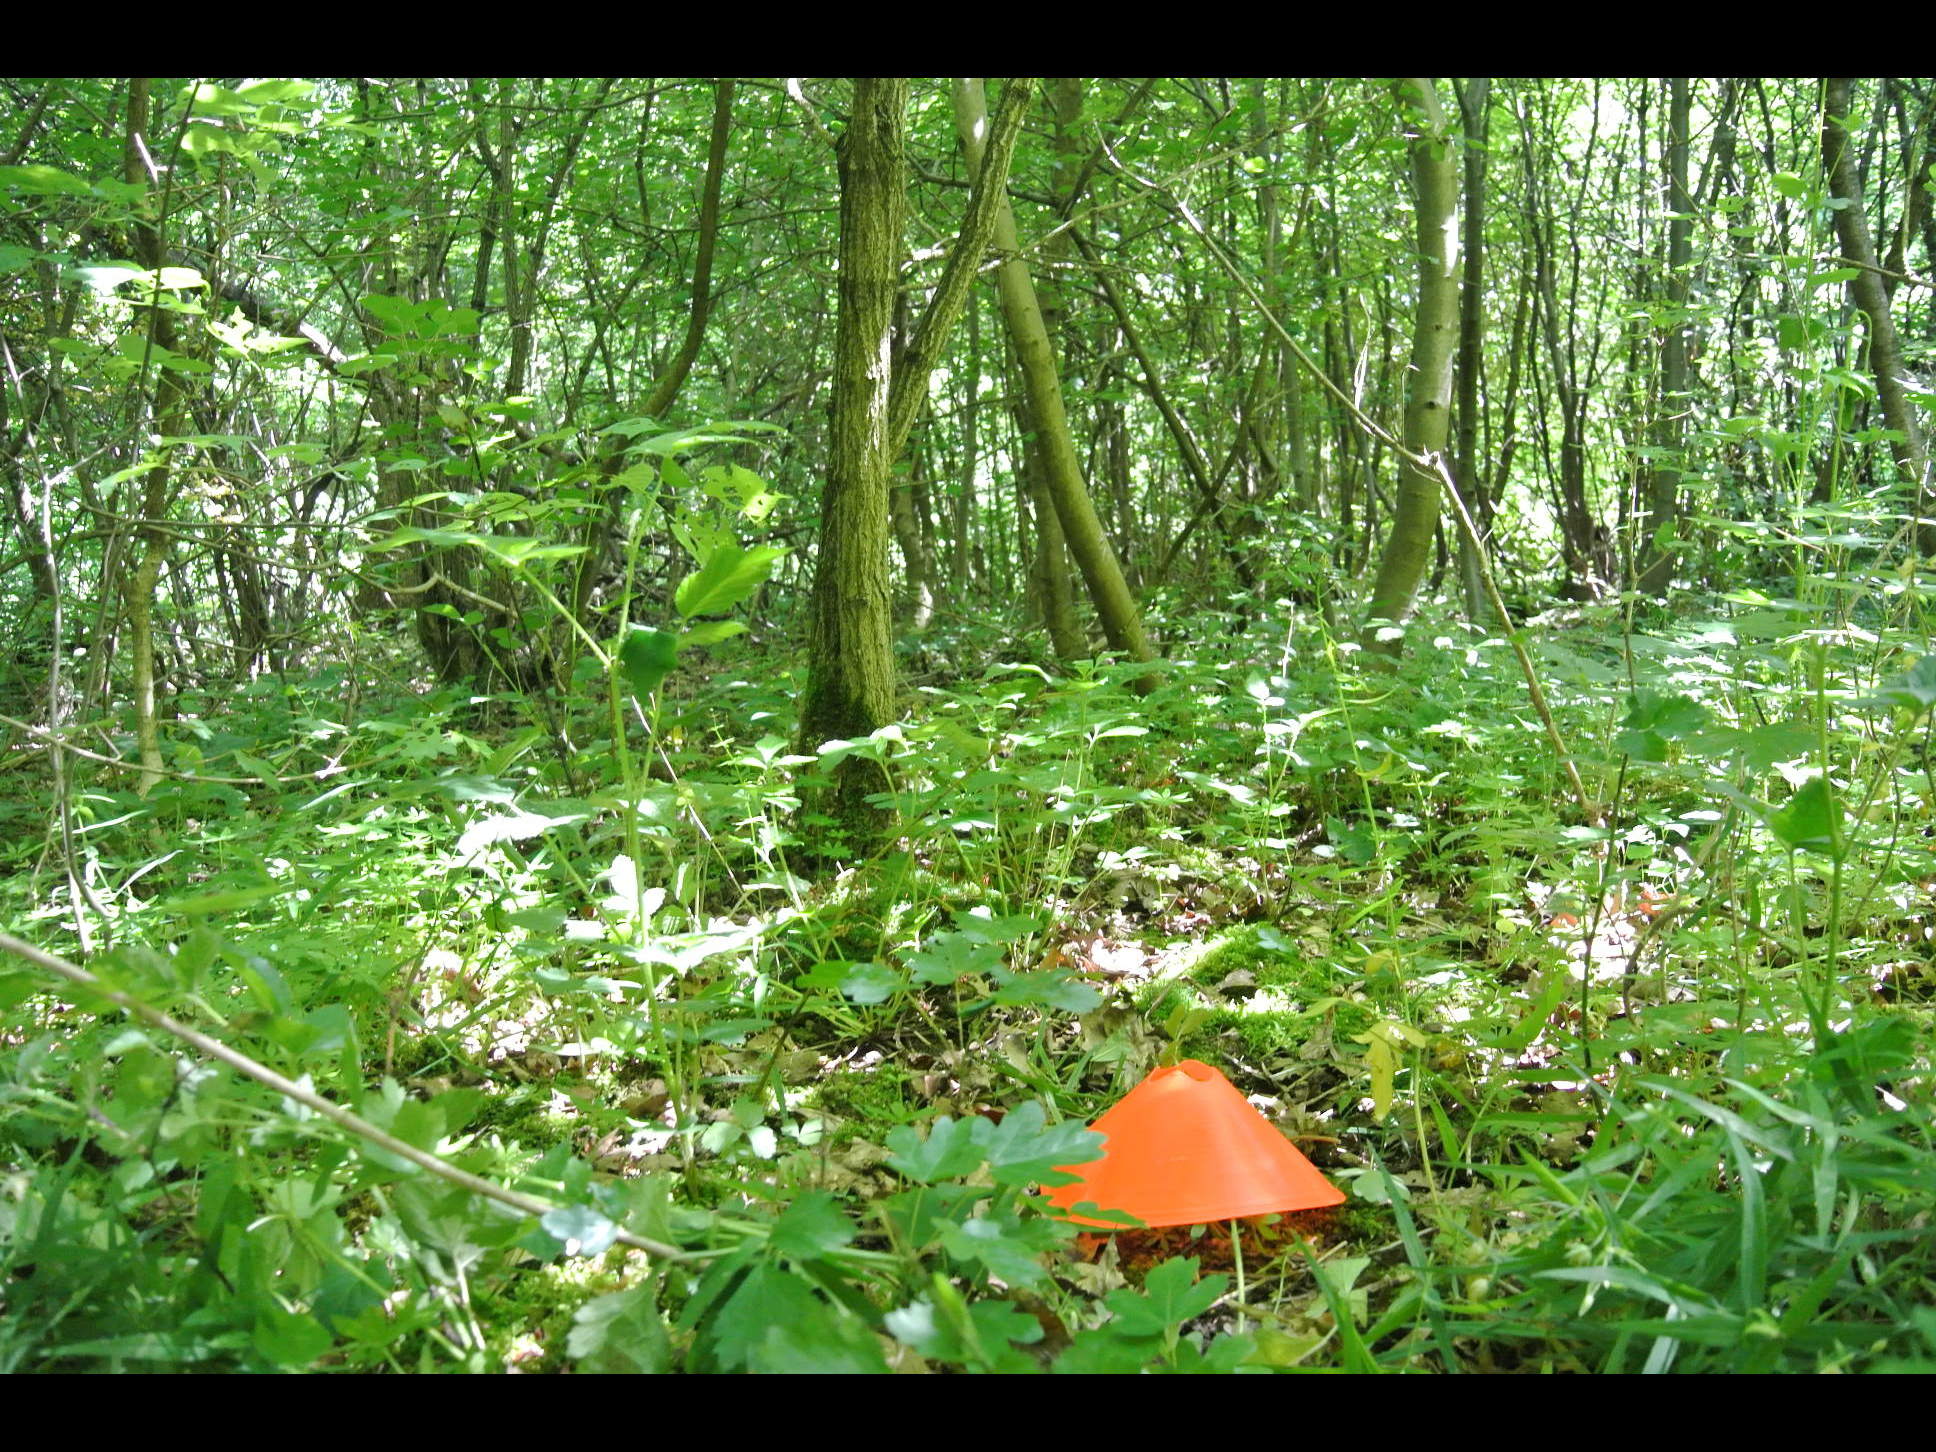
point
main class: Woodland
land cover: Broadleaved woodland
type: mesophytic deciduous forest
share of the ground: > 75 %
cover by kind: broadleaved forest trees 90 %, shrubs 10 %
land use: Forestry
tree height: > 5 m
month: May
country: AT
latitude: 47.9515
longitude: 16.6335
